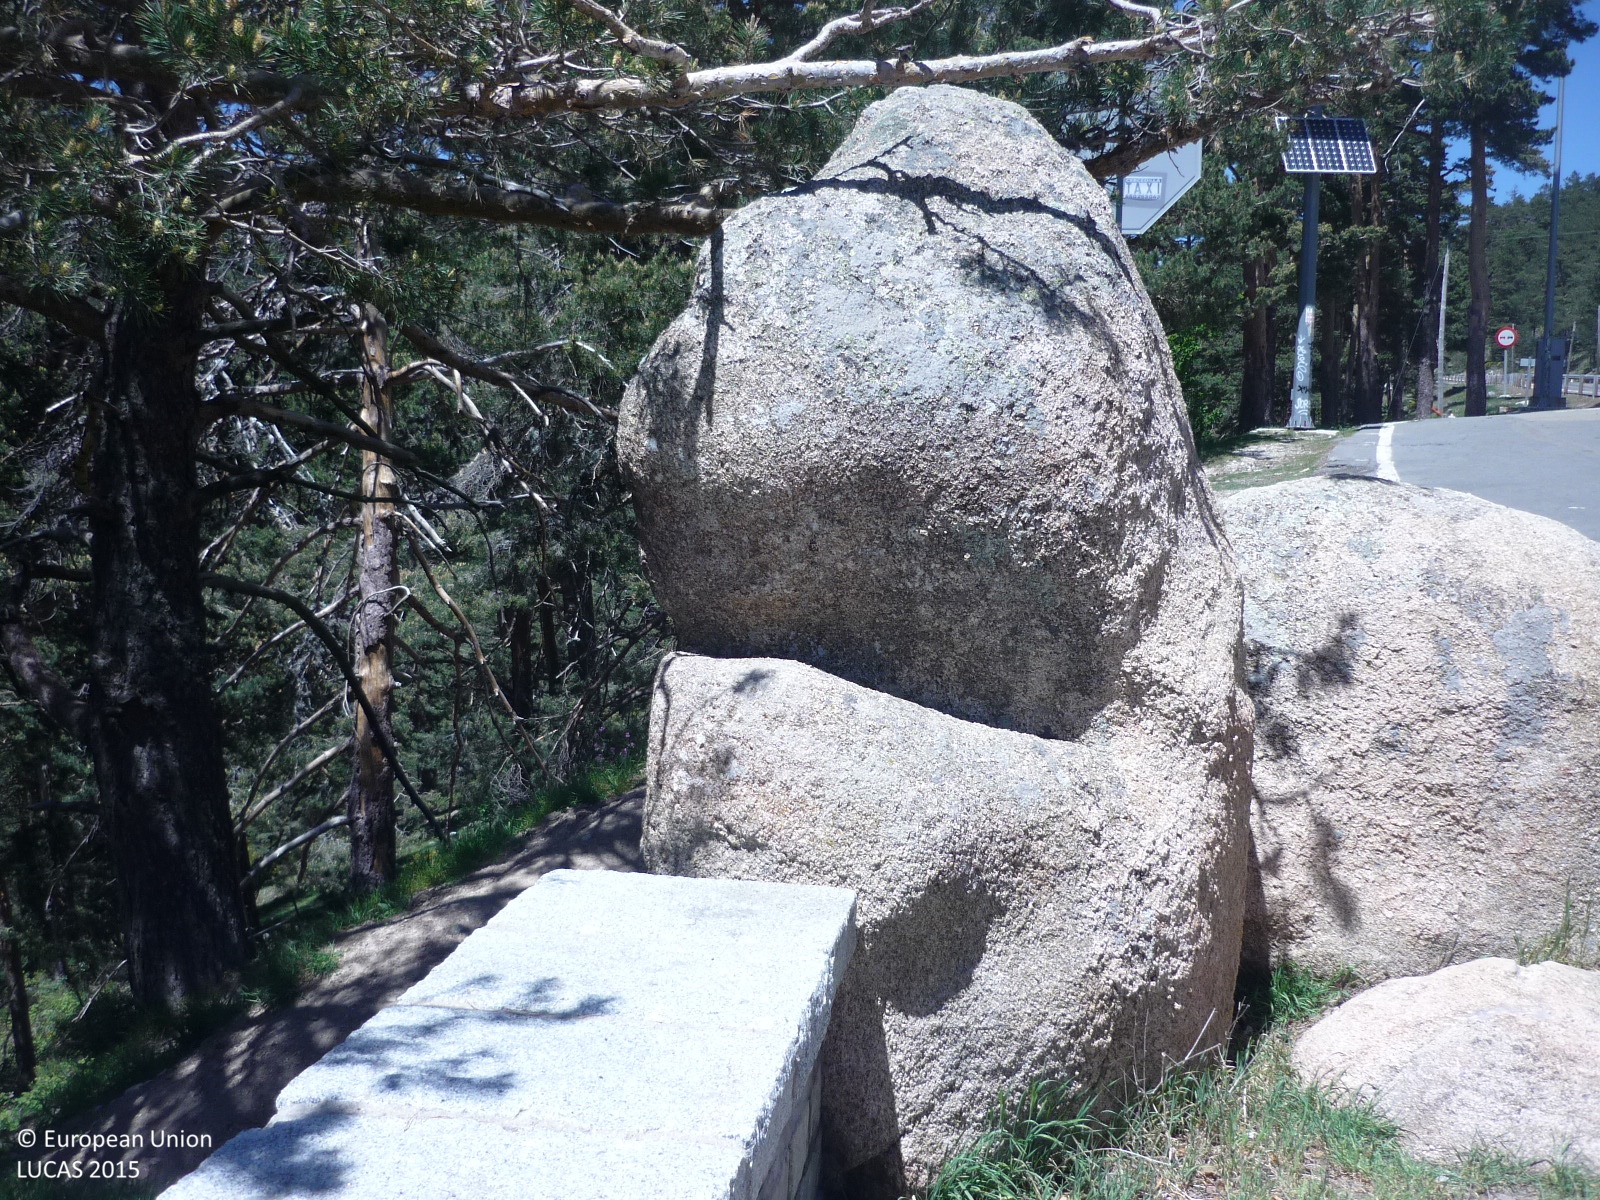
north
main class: Woodland
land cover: Pine dominated coniferous woodland
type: coniferous forest of the mediterranean region
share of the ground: > 75 %
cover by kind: coniferous forest trees 85 %, shrubs 10 %, herbaceous plants 5 %
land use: Forestry
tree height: > 5 m
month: May
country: ES
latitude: 40.7768
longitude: -4.0161
